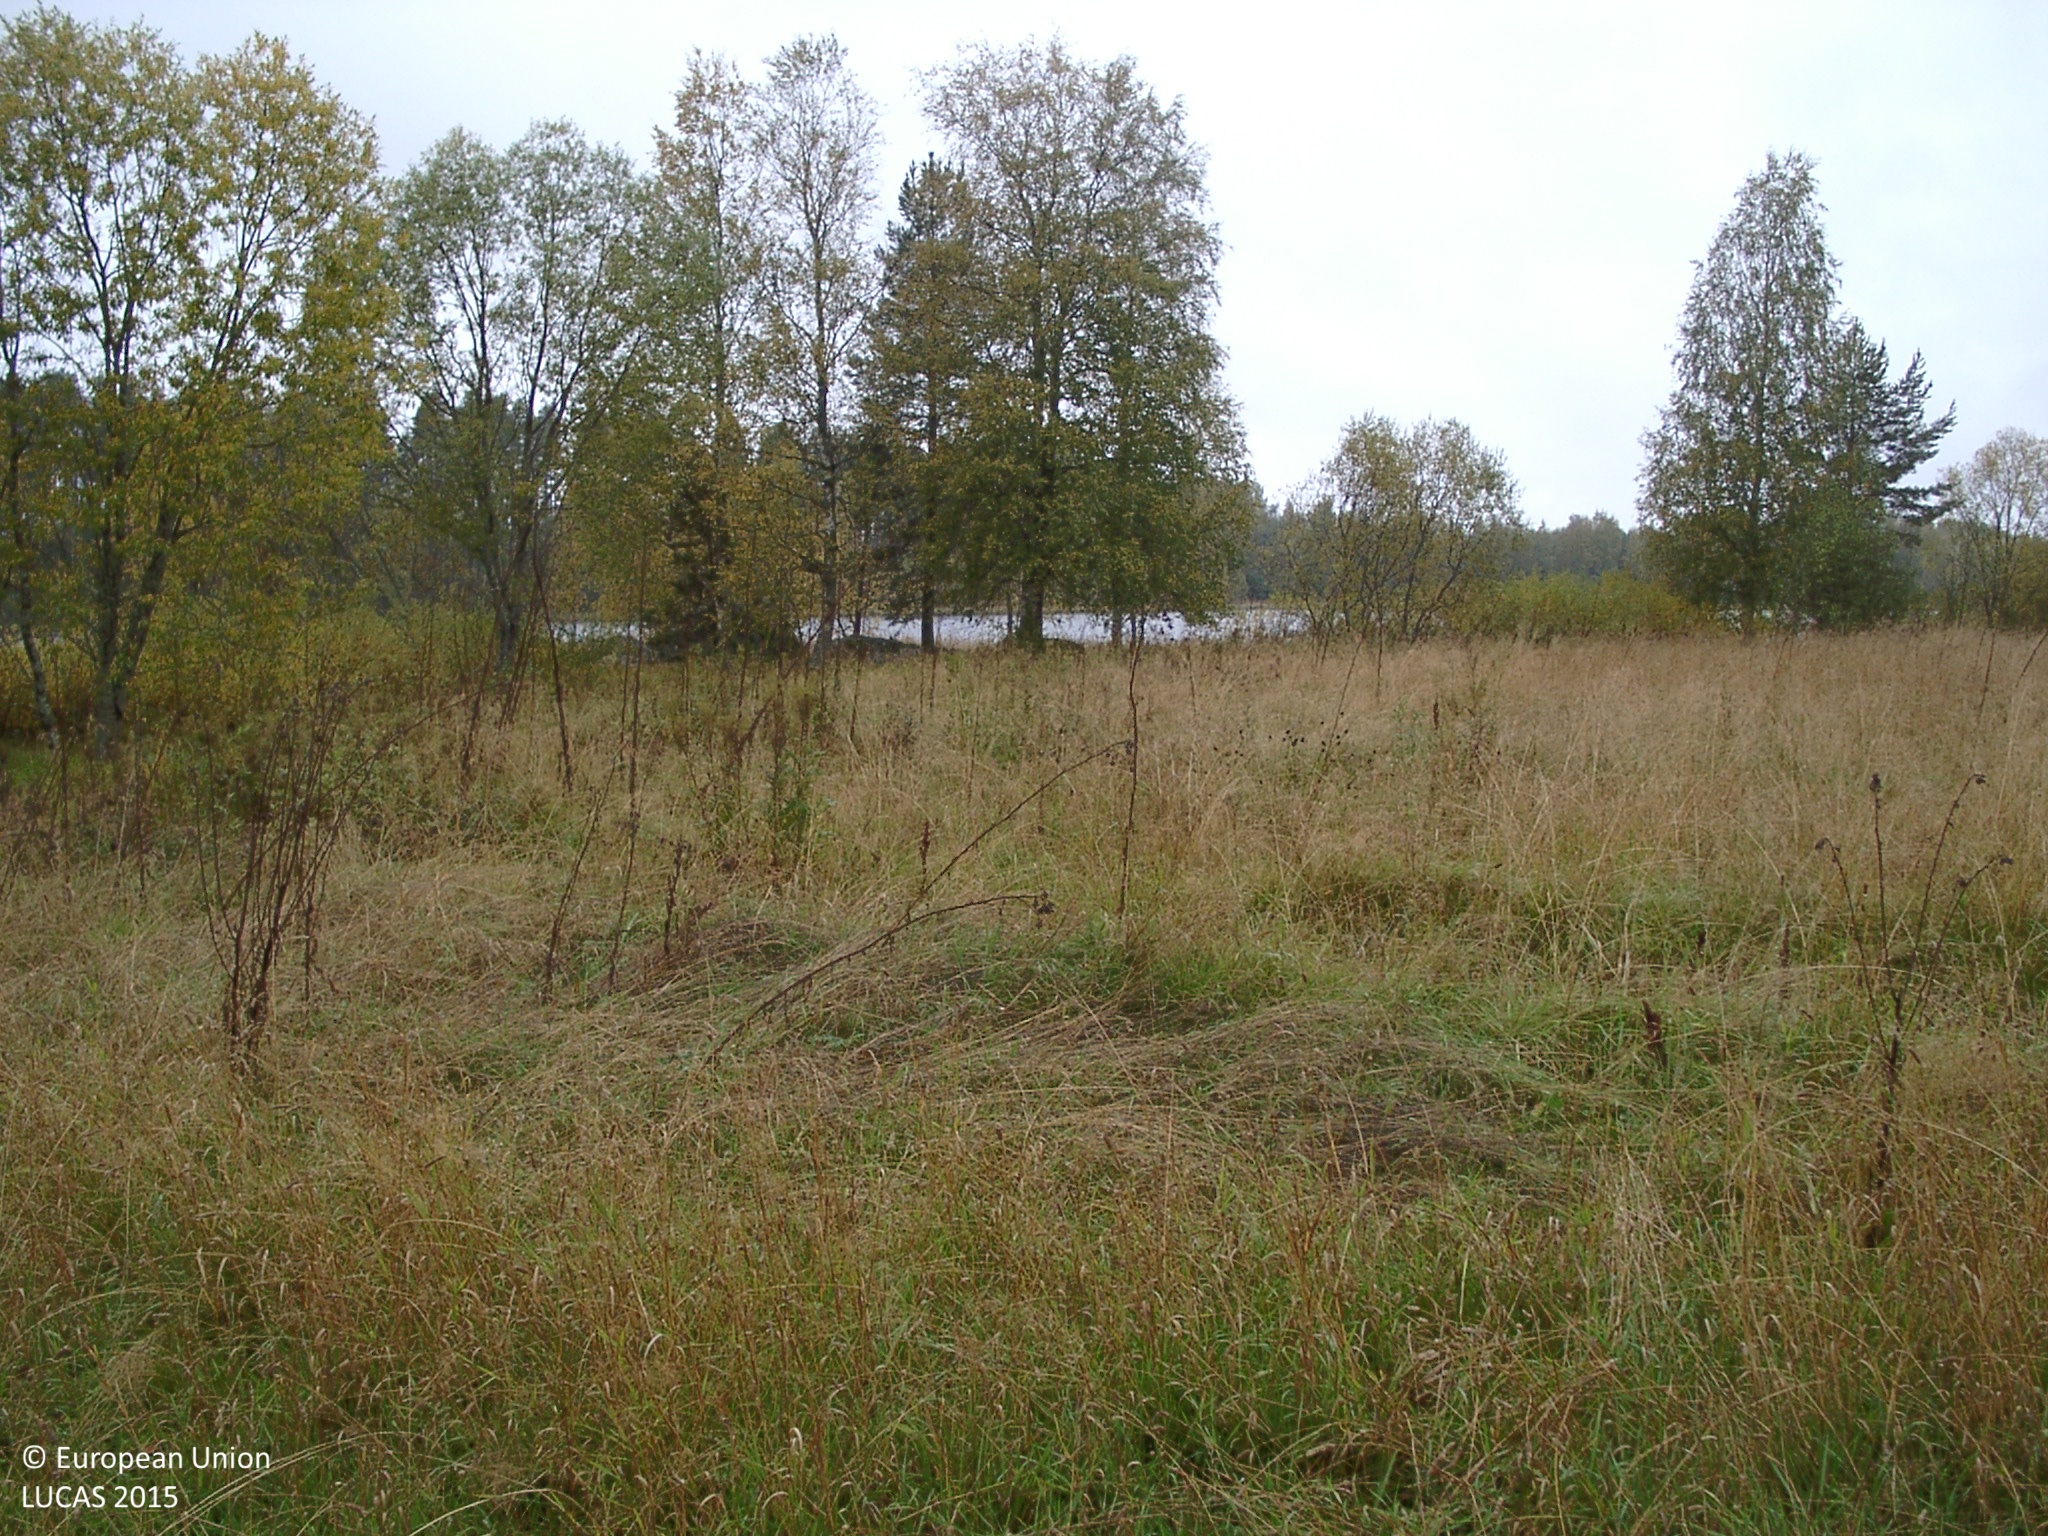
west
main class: Grassland
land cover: Grassland without tree/shrub cover
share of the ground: > 75 %
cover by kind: herbaceous plants 100 %
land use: Agriculture (excluding fallow land and kitchen gardens)
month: September
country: FI
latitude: 62.7595
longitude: 25.5214
